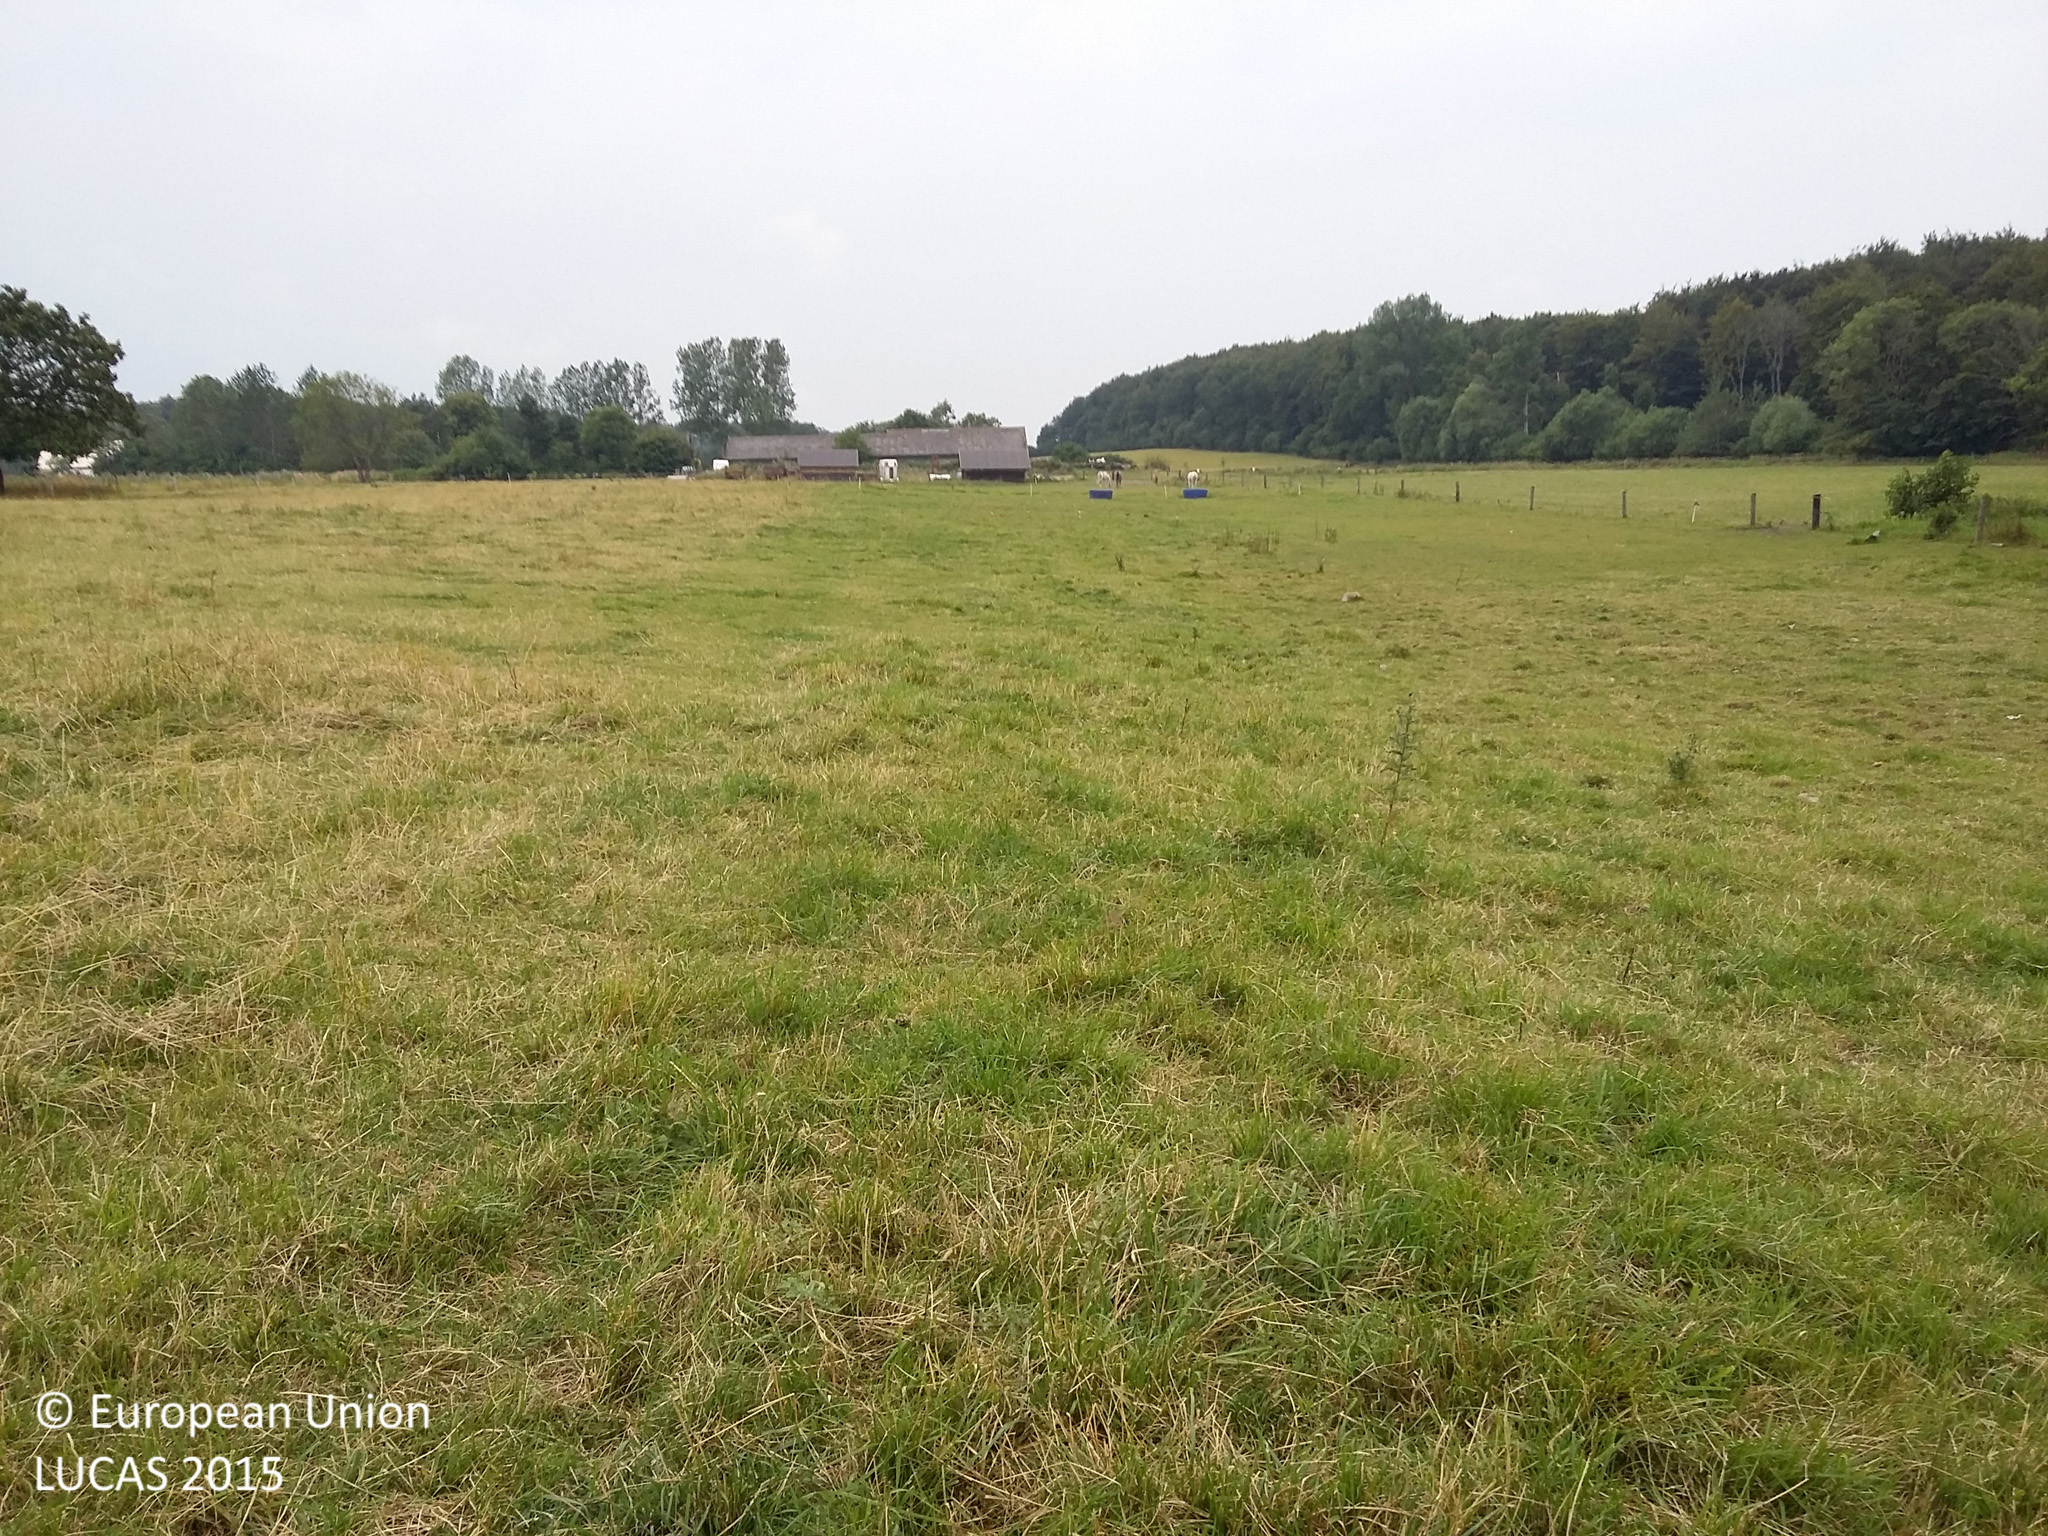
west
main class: Grassland
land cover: Grassland without tree/shrub cover
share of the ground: > 75 %
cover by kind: herbaceous plants 100 %
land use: Agriculture (excluding fallow land and kitchen gardens)
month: August
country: DK
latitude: 55.4938
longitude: 11.6605
